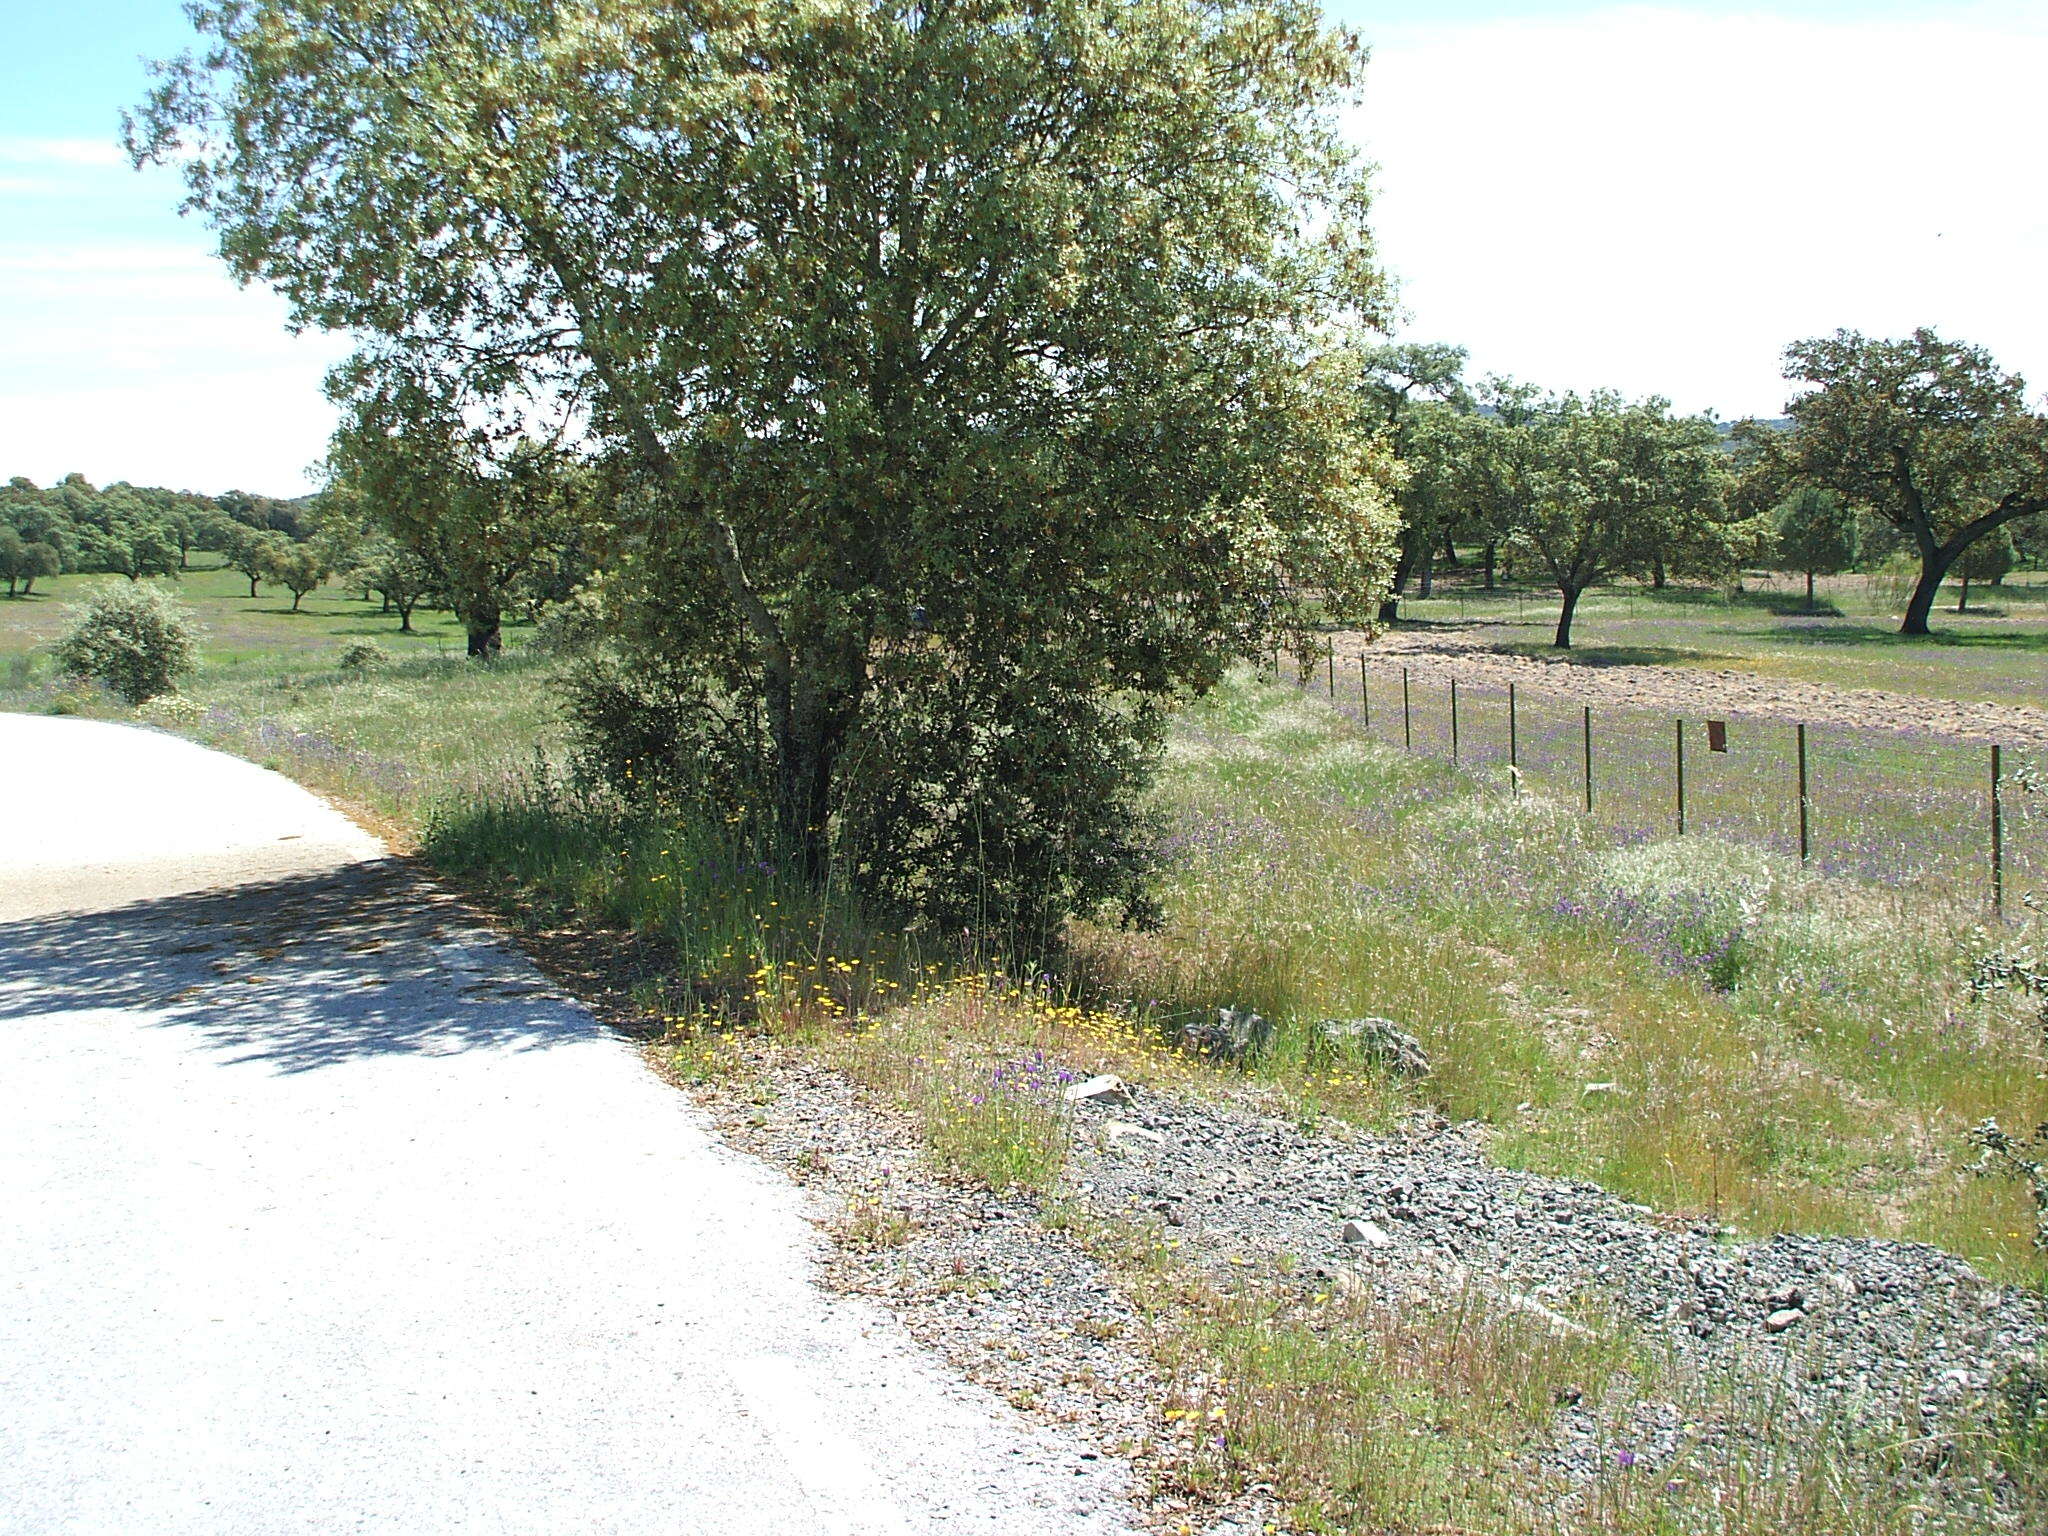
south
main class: Woodland
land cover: Broadleaved woodland
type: broadleaved evergreen forest
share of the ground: 25 - 50 %
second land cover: Grassland without tree/shrub cover
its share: > 75 %
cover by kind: herbaceous plants 60 %, broadleaved forest trees 40 %
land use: Forestry
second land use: Agriculture (excluding fallow land and kitchen gardens)
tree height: > 5 m
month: April
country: ES
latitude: 37.7683
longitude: -5.6574
